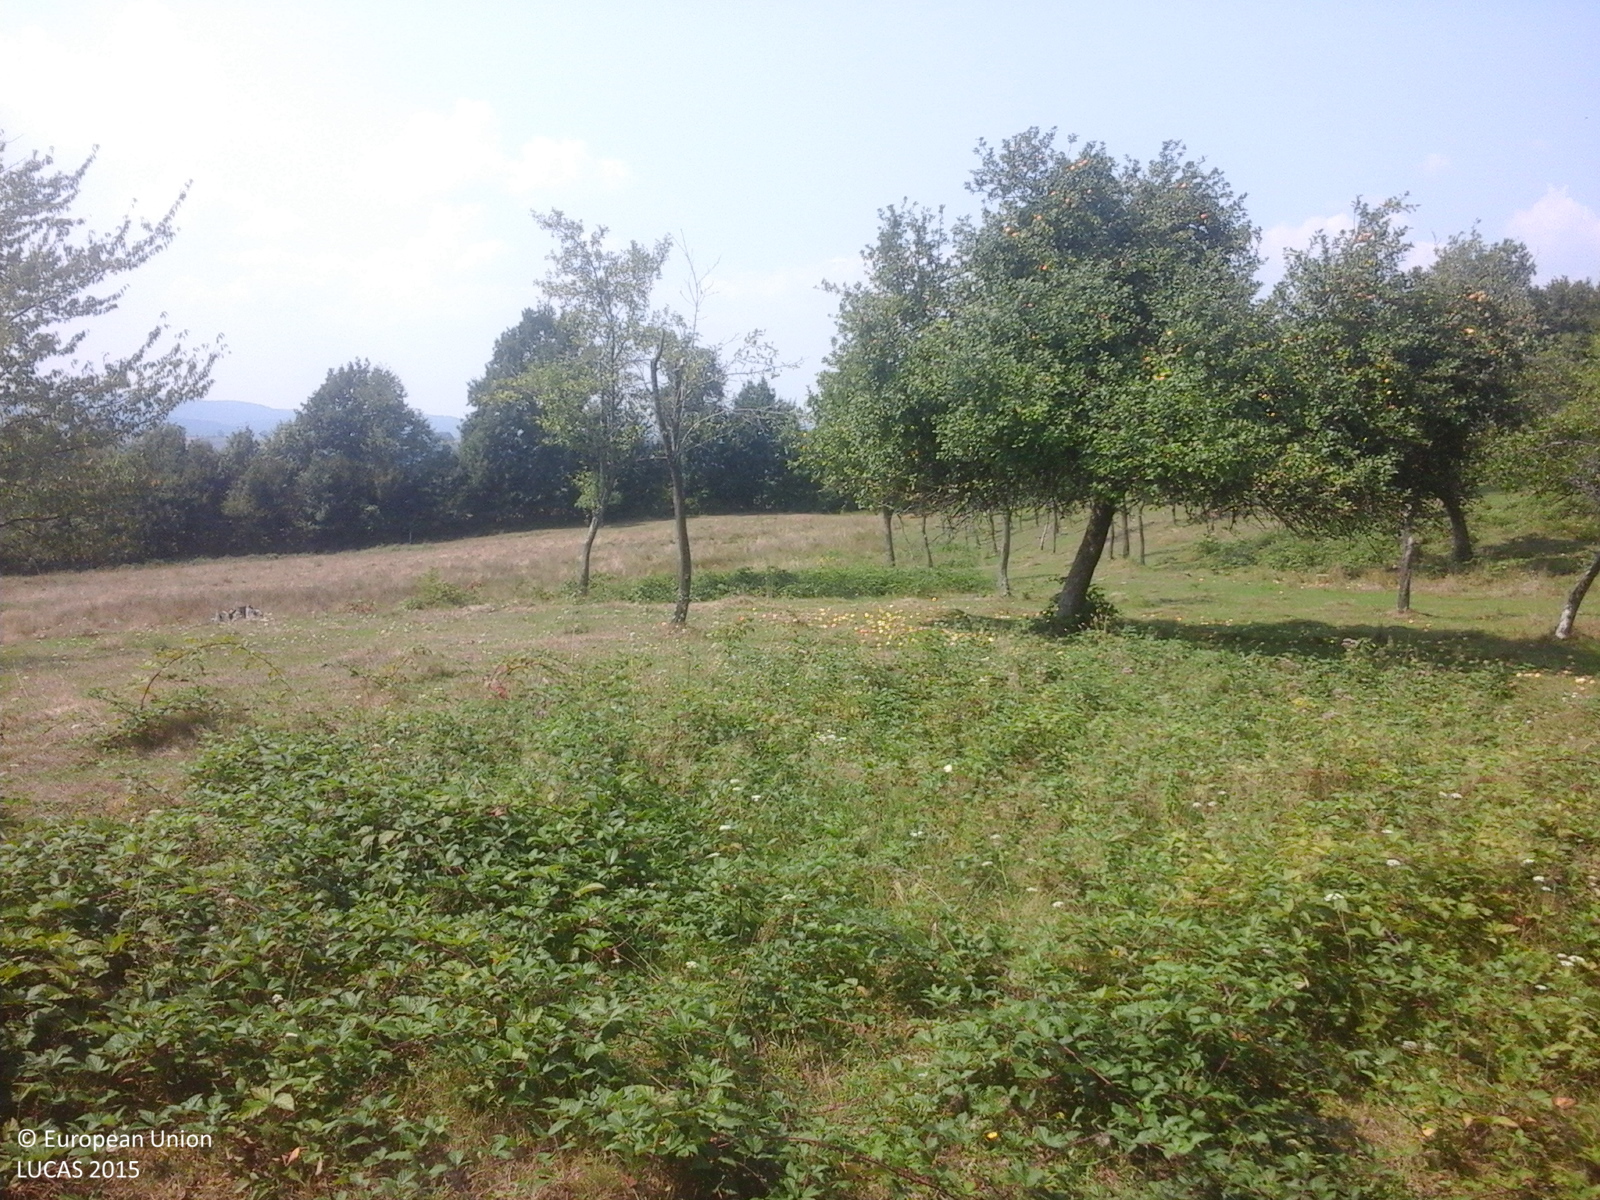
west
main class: Cropland
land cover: Apple fruit
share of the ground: > 75 %
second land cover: Grassland without tree/shrub cover
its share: > 75 %
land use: Agriculture (excluding fallow land and kitchen gardens)
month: August
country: RO
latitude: 46.3182
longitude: 22.5578
